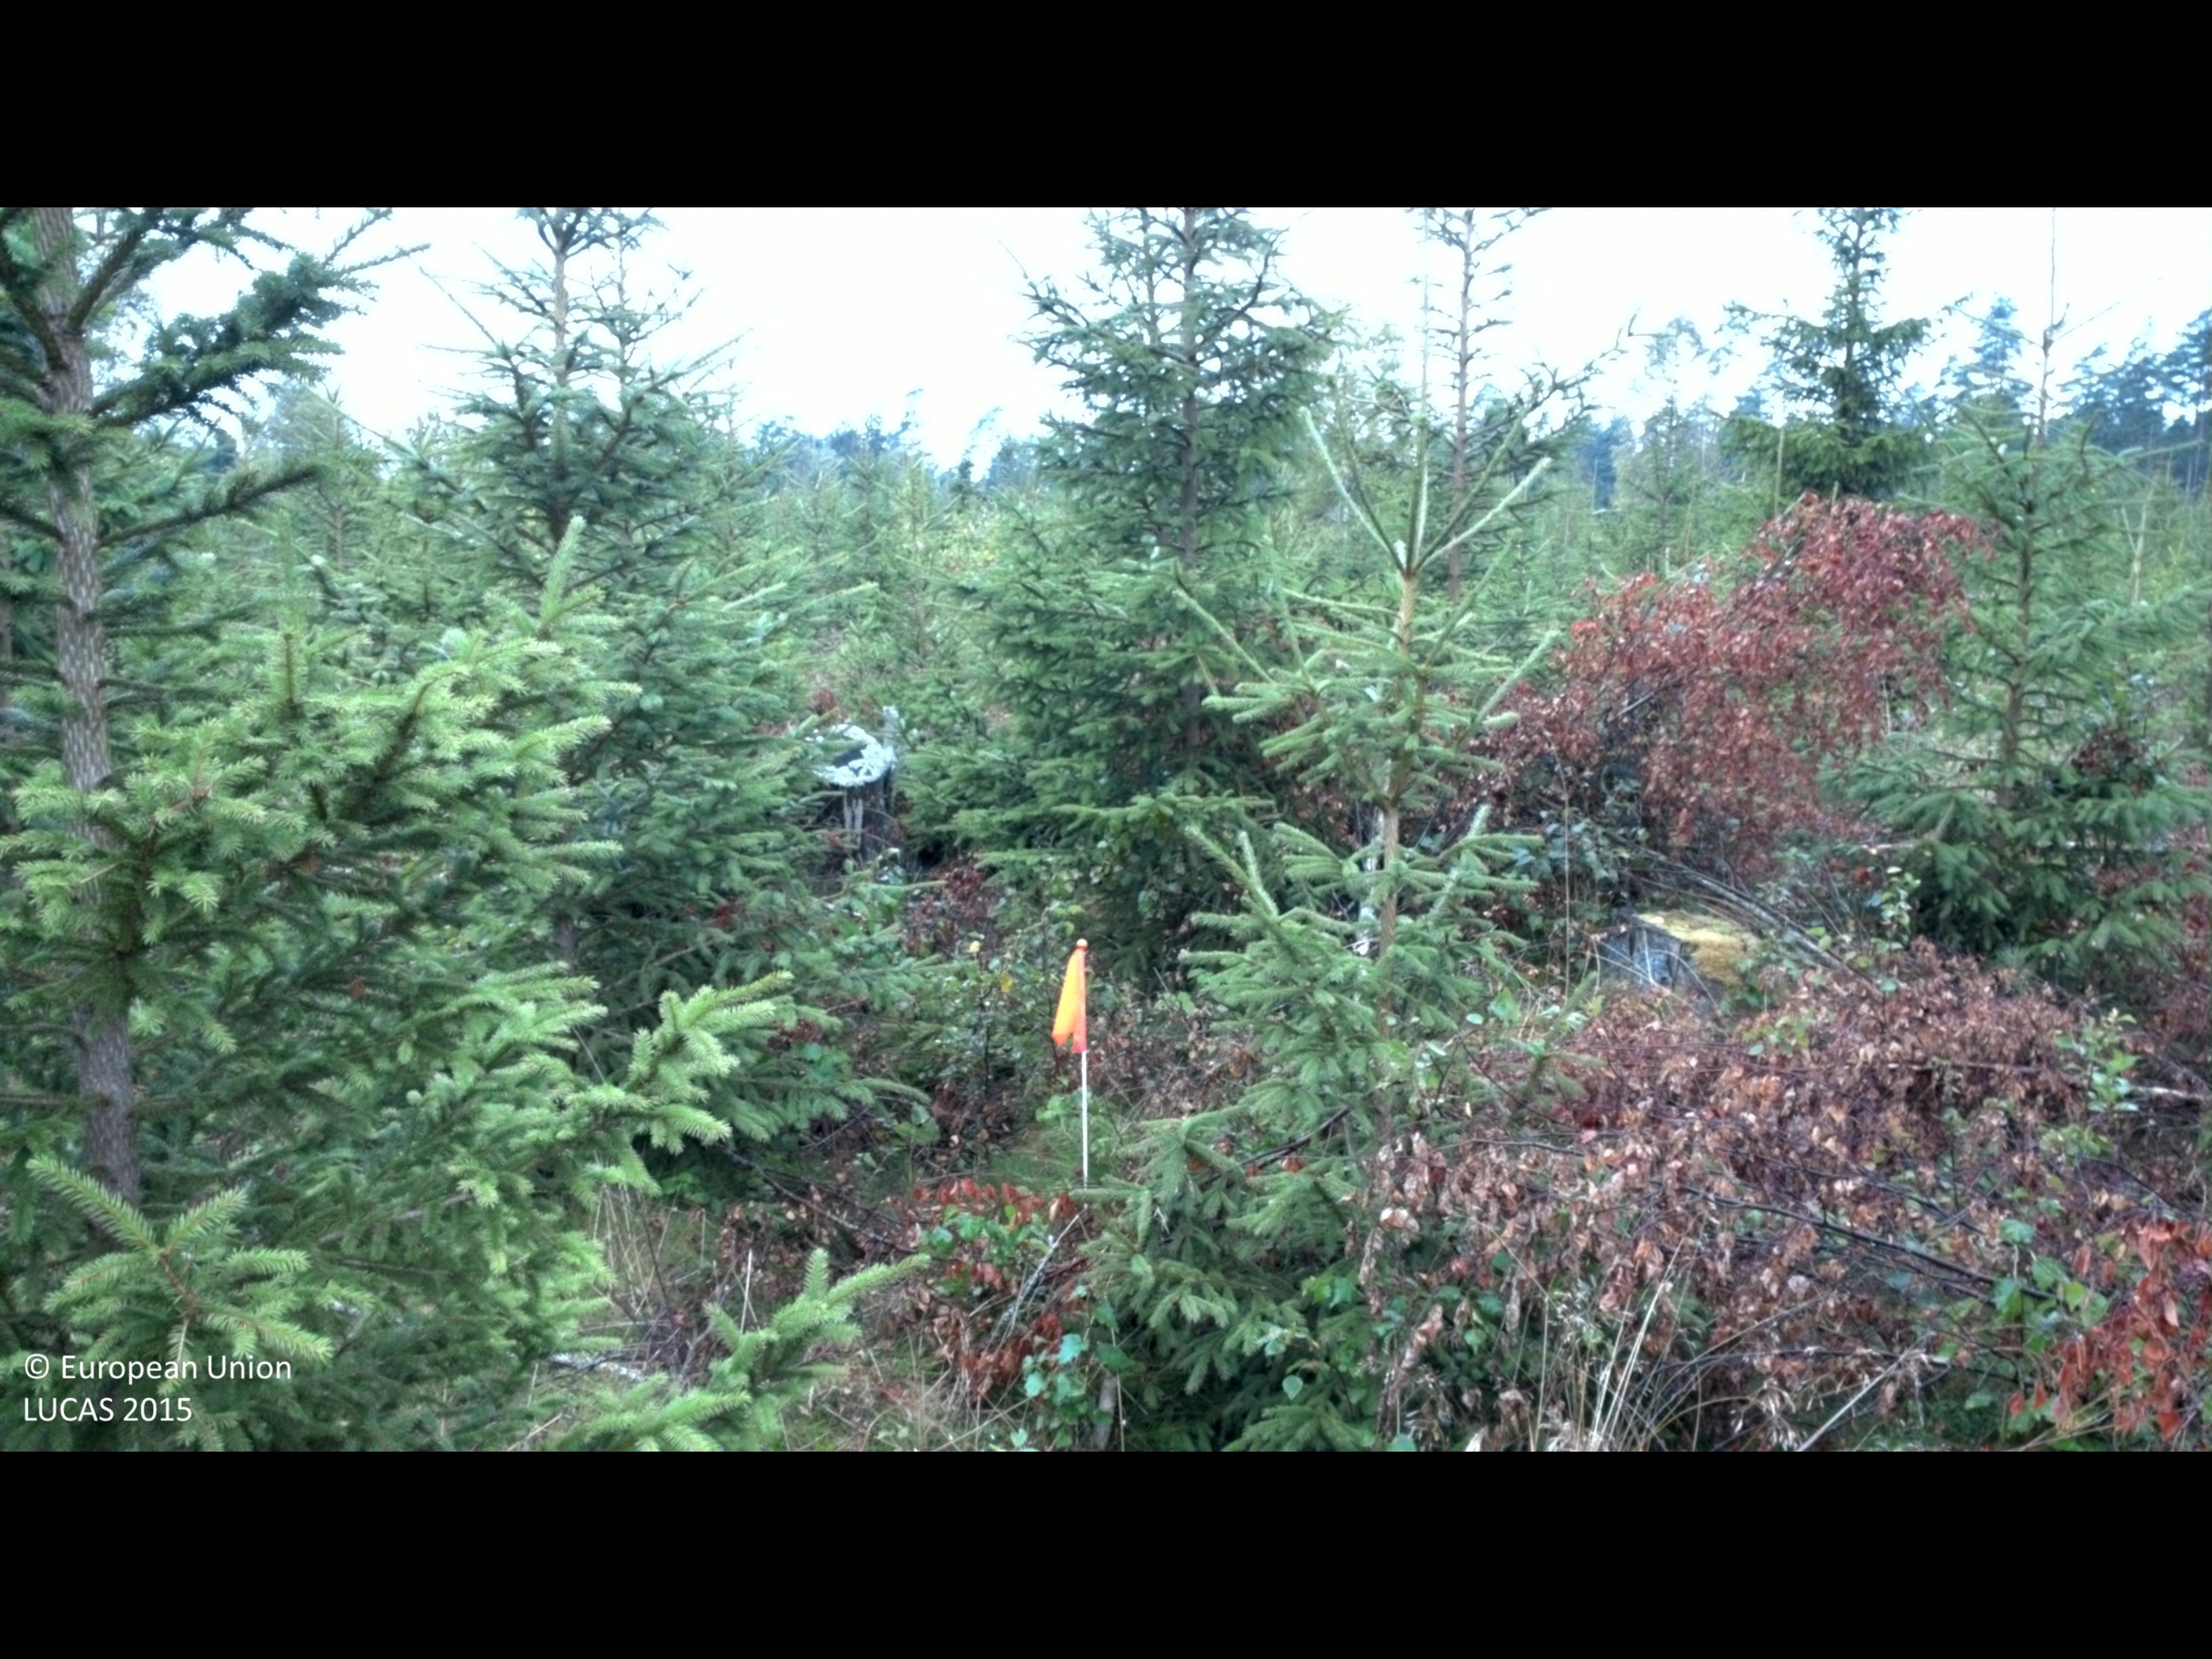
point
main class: Woodland
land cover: Spruce dominated coniferous woodland
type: boreal forest
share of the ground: 50 - 75 %
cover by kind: coniferous forest trees 60 %, shrubs 20 %, herbaceous plants 15 %, broadleaved forest trees 5 %
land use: Forestry
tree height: < 5 m
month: August
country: SE
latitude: 56.9216
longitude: 13.2000
